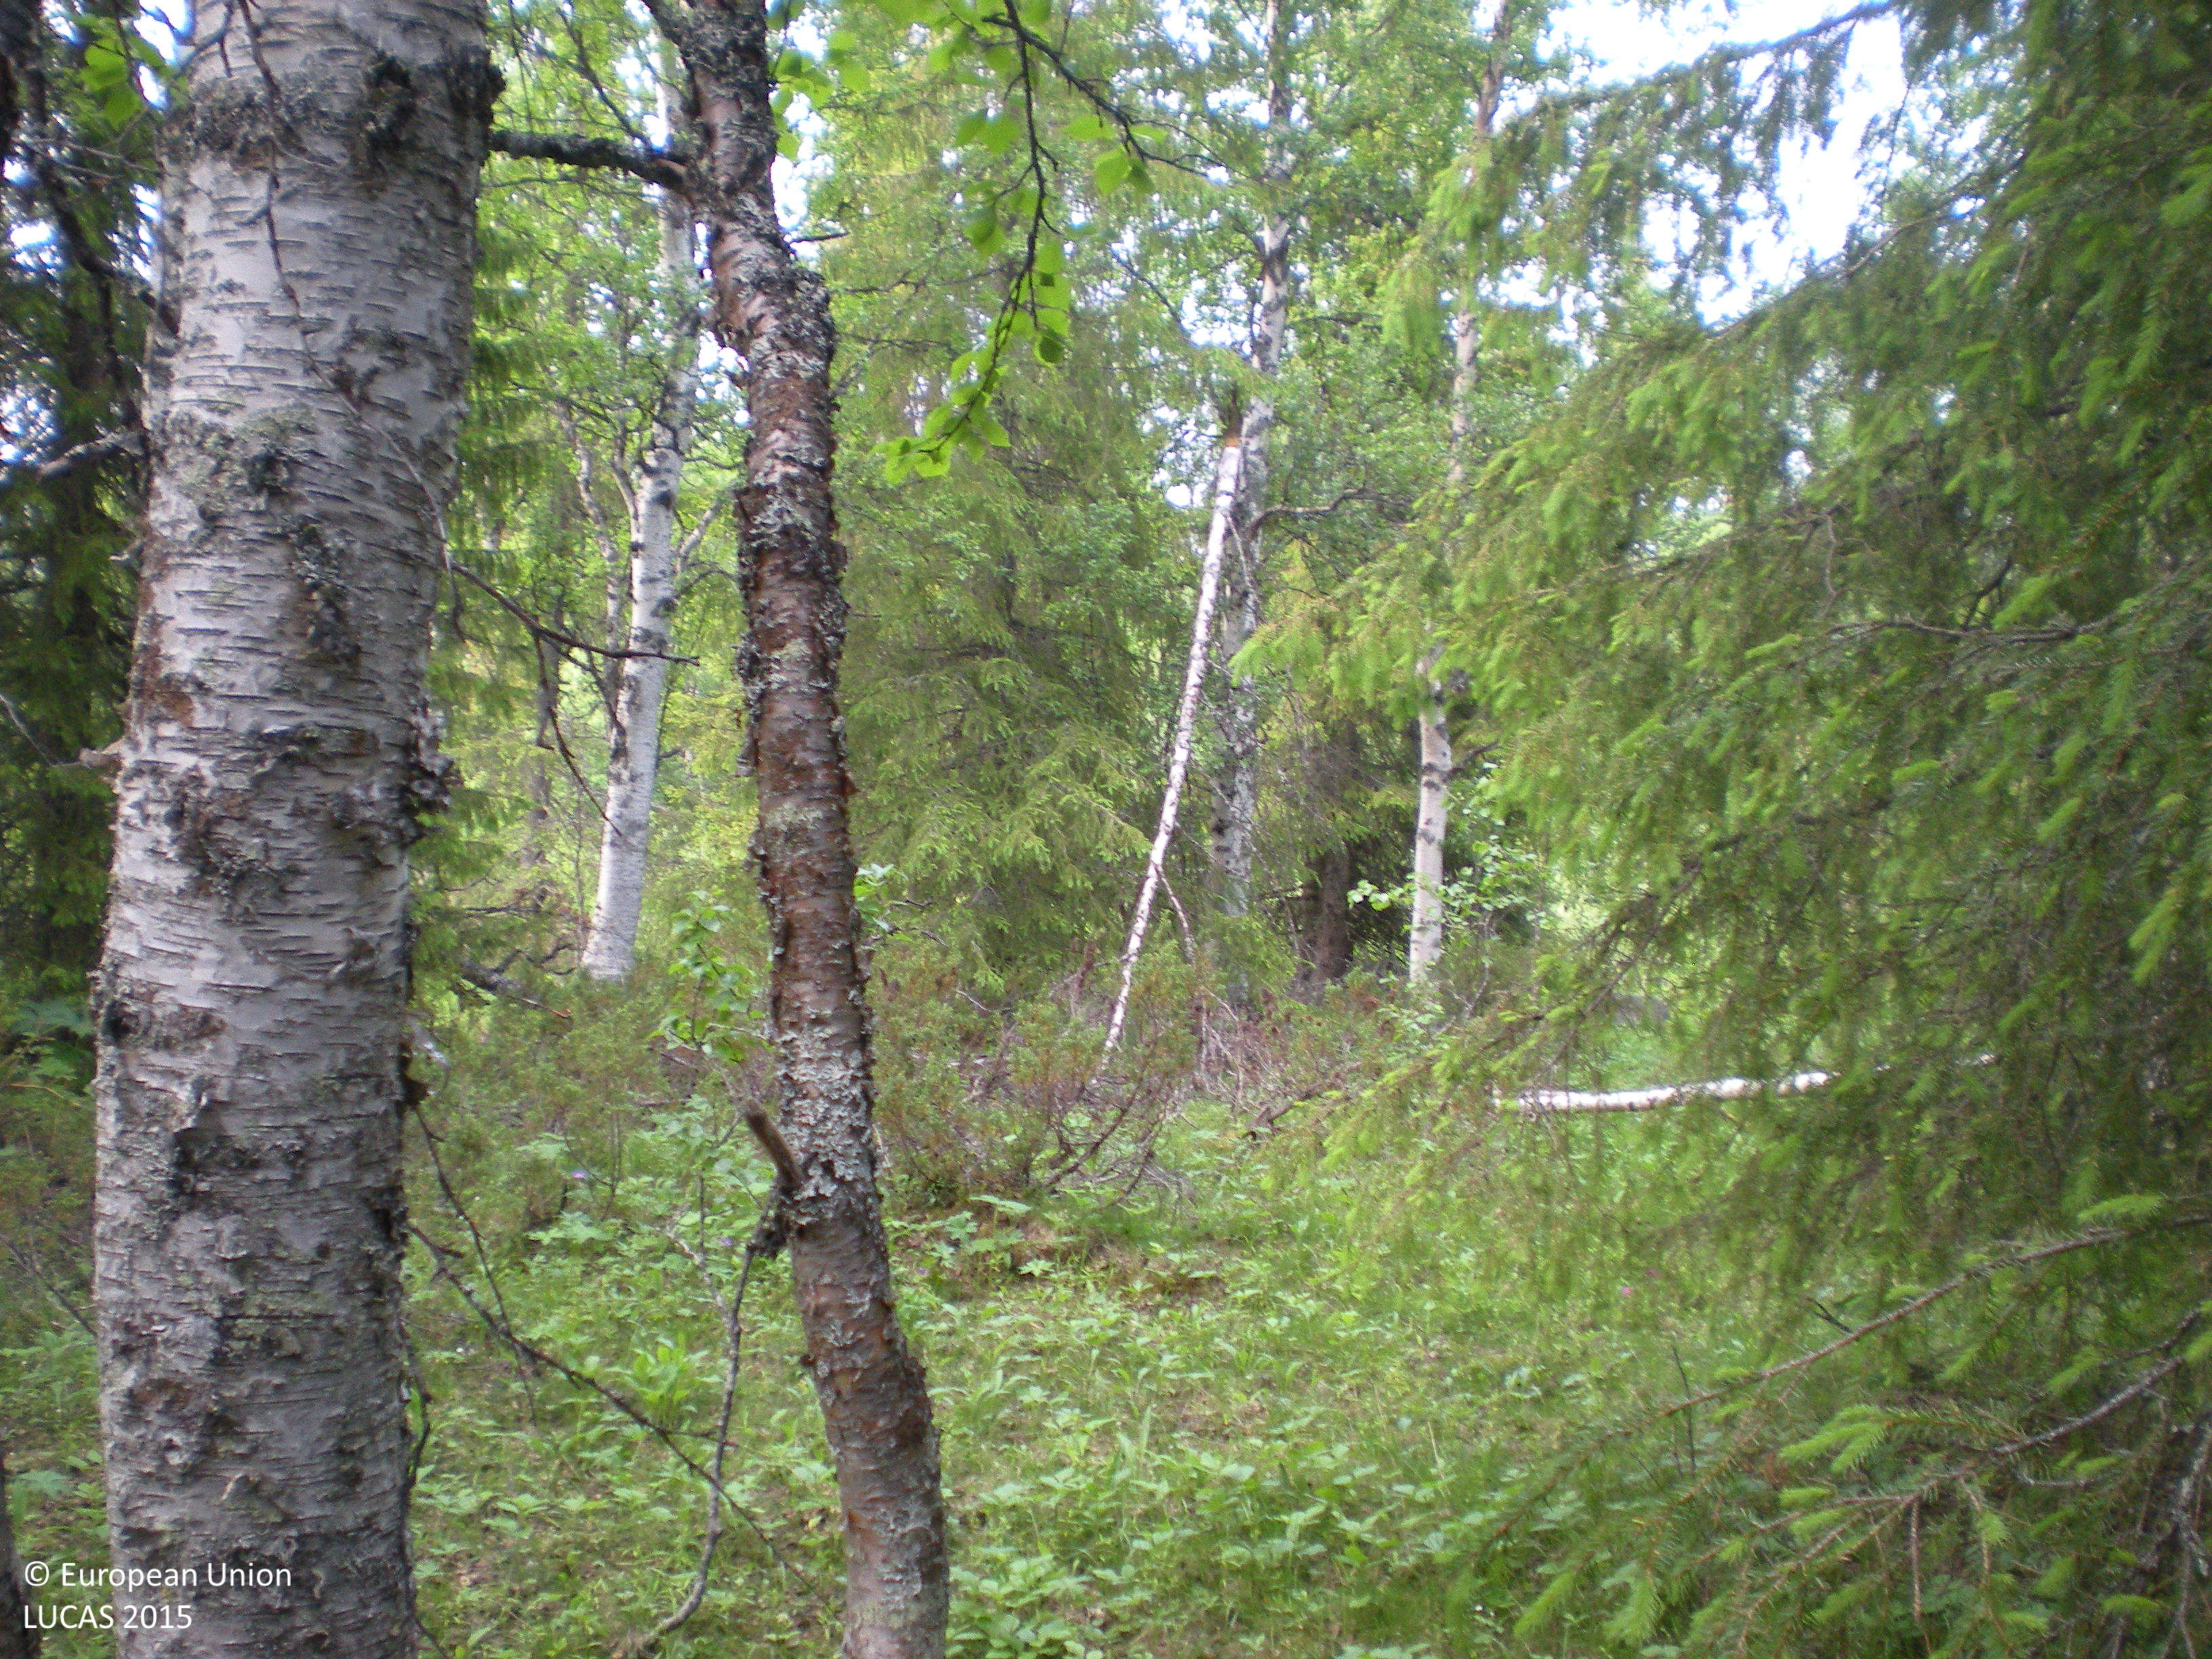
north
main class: Woodland
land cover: Spruce dominated mixed woodland
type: boreal forest
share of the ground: 50 - 75 %
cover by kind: coniferous forest trees 45 %, broadleaved forest trees 30 %, herbaceous plants 15 %, shrubs 5 %, lichens and mosses 5 %
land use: Forestry
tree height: > 5 m
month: July
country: SE
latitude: 65.6959
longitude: 16.9922
